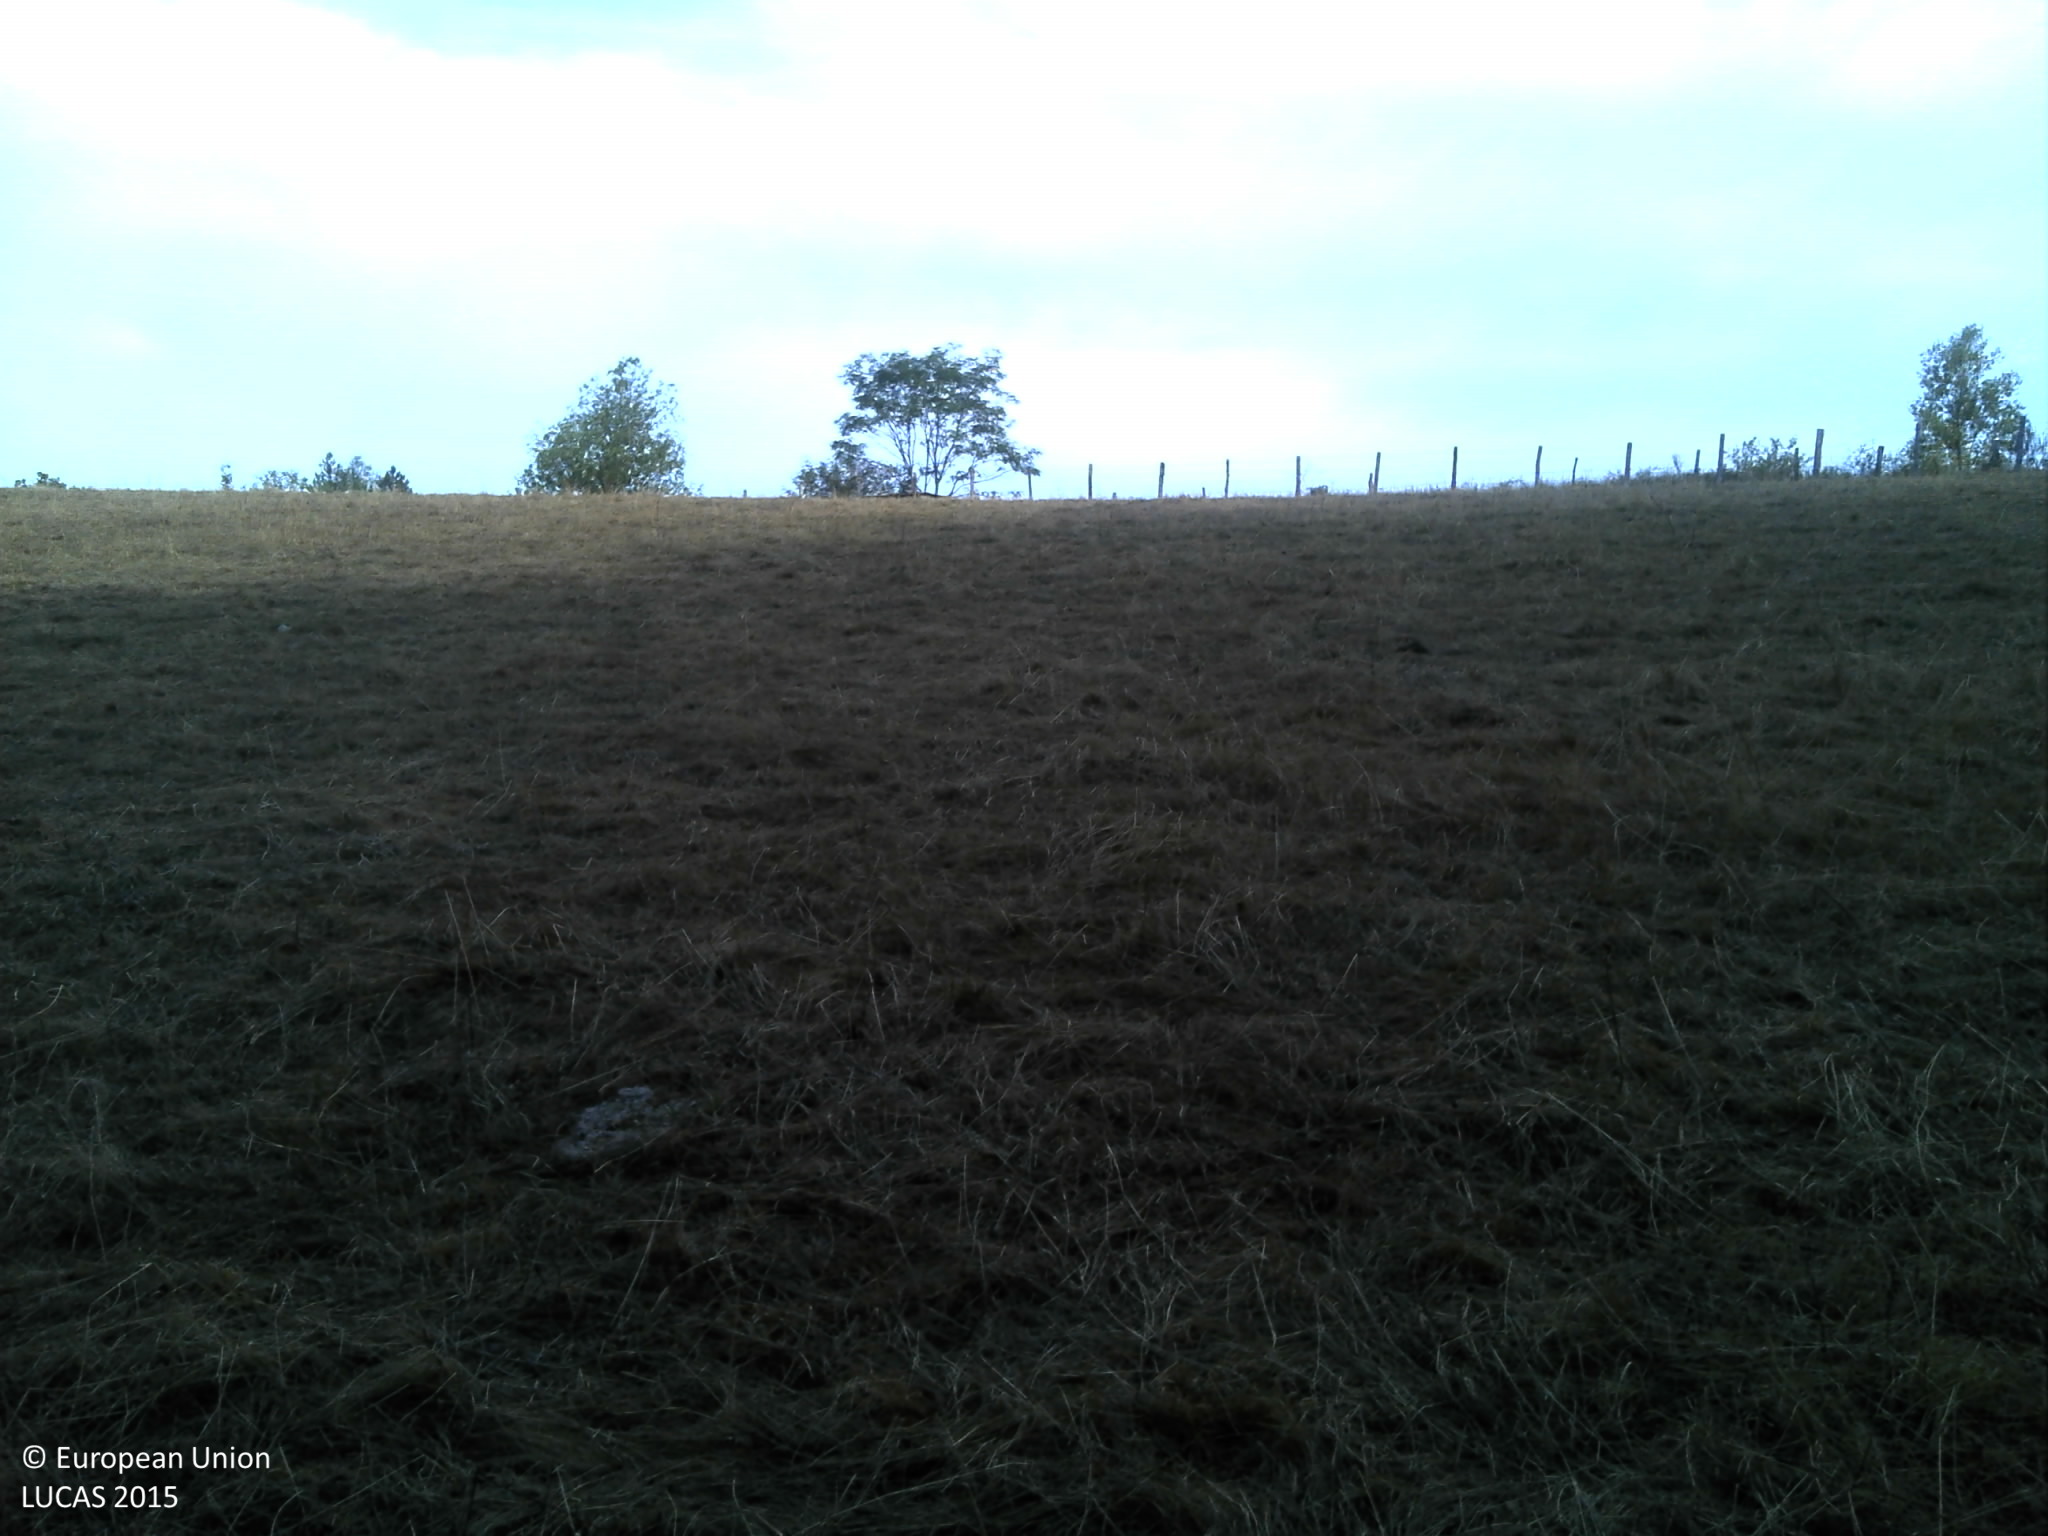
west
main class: Grassland
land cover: Grassland without tree/shrub cover
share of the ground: > 75 %
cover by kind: herbaceous plants 100 %
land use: Agriculture (excluding fallow land and kitchen gardens)
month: July
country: FR
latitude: 45.0944
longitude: 1.5712
